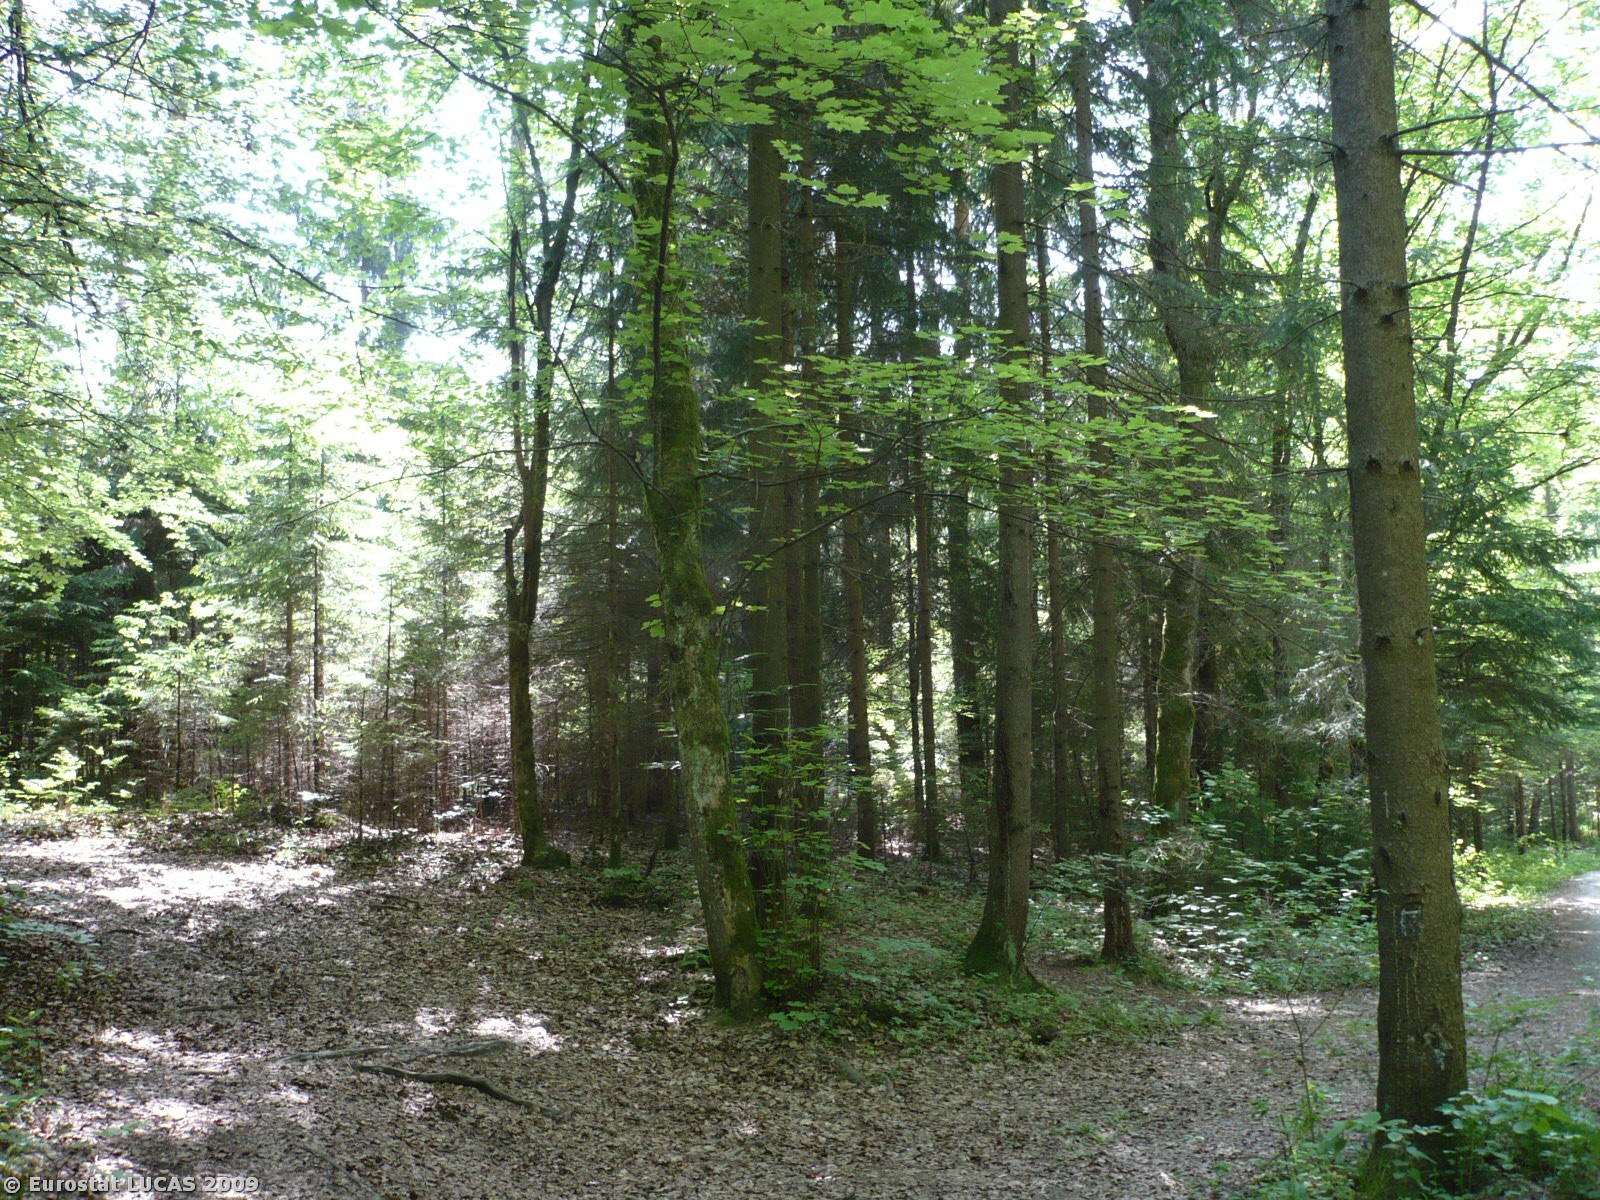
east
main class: Woodland
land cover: Mixed woodland
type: hemiboreal forest and nemoral coniferous forest and mixed broadleaved-coniferous forest
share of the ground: > 75 %
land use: Amenities, museums, leisure
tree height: > 5 m
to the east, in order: Mixed woodland; Tracks; Mixed woodland; Coniferous woodland; Mixed woodland; Broadleaved woodland
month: May
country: SI
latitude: 46.2810
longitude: 14.3446
